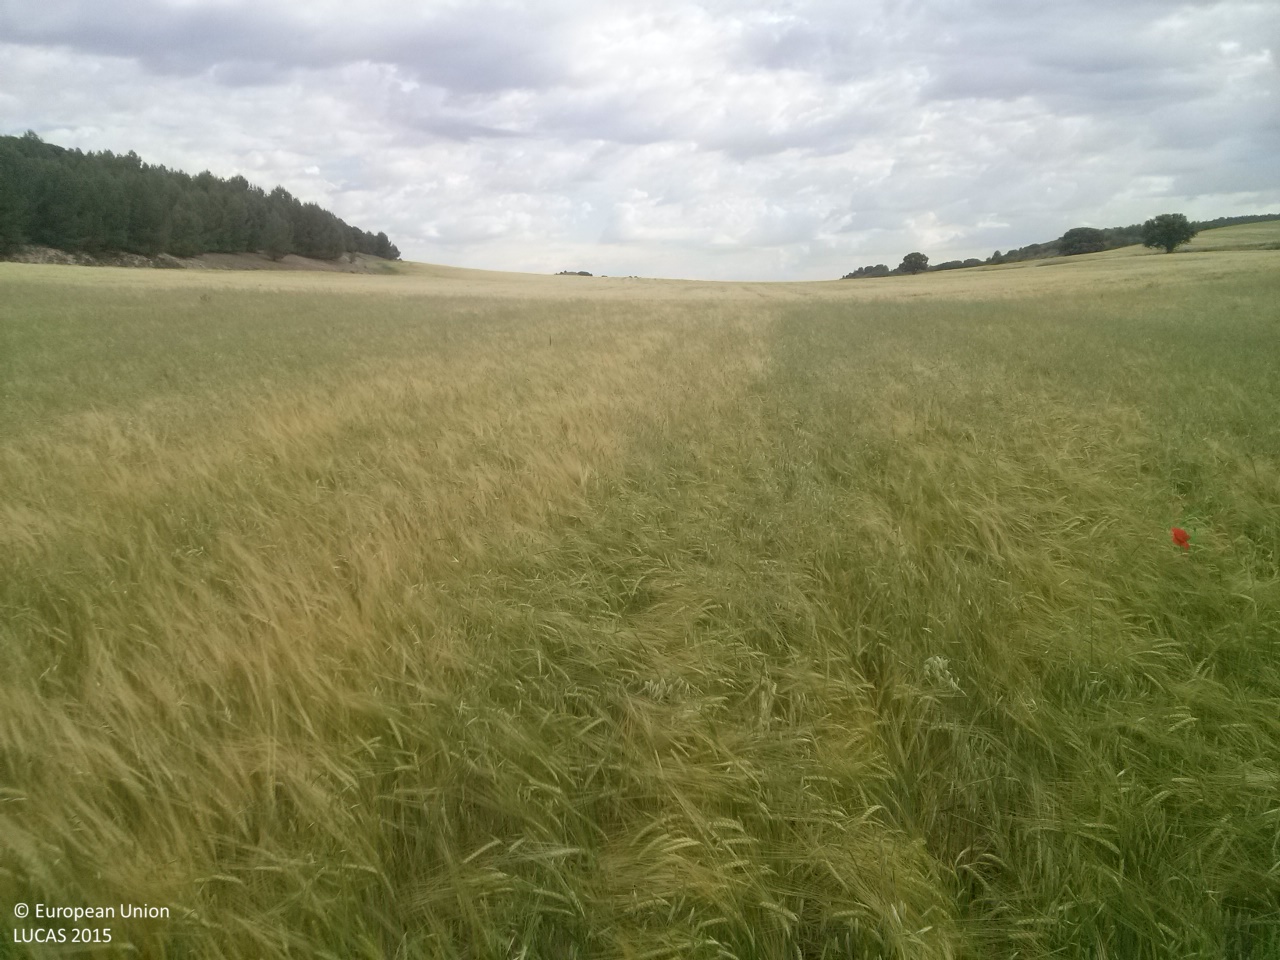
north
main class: Cropland
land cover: Barley
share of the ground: > 75 %
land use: Agriculture (excluding fallow land and kitchen gardens)
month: May
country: ES
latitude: 40.0692
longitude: -2.9094
